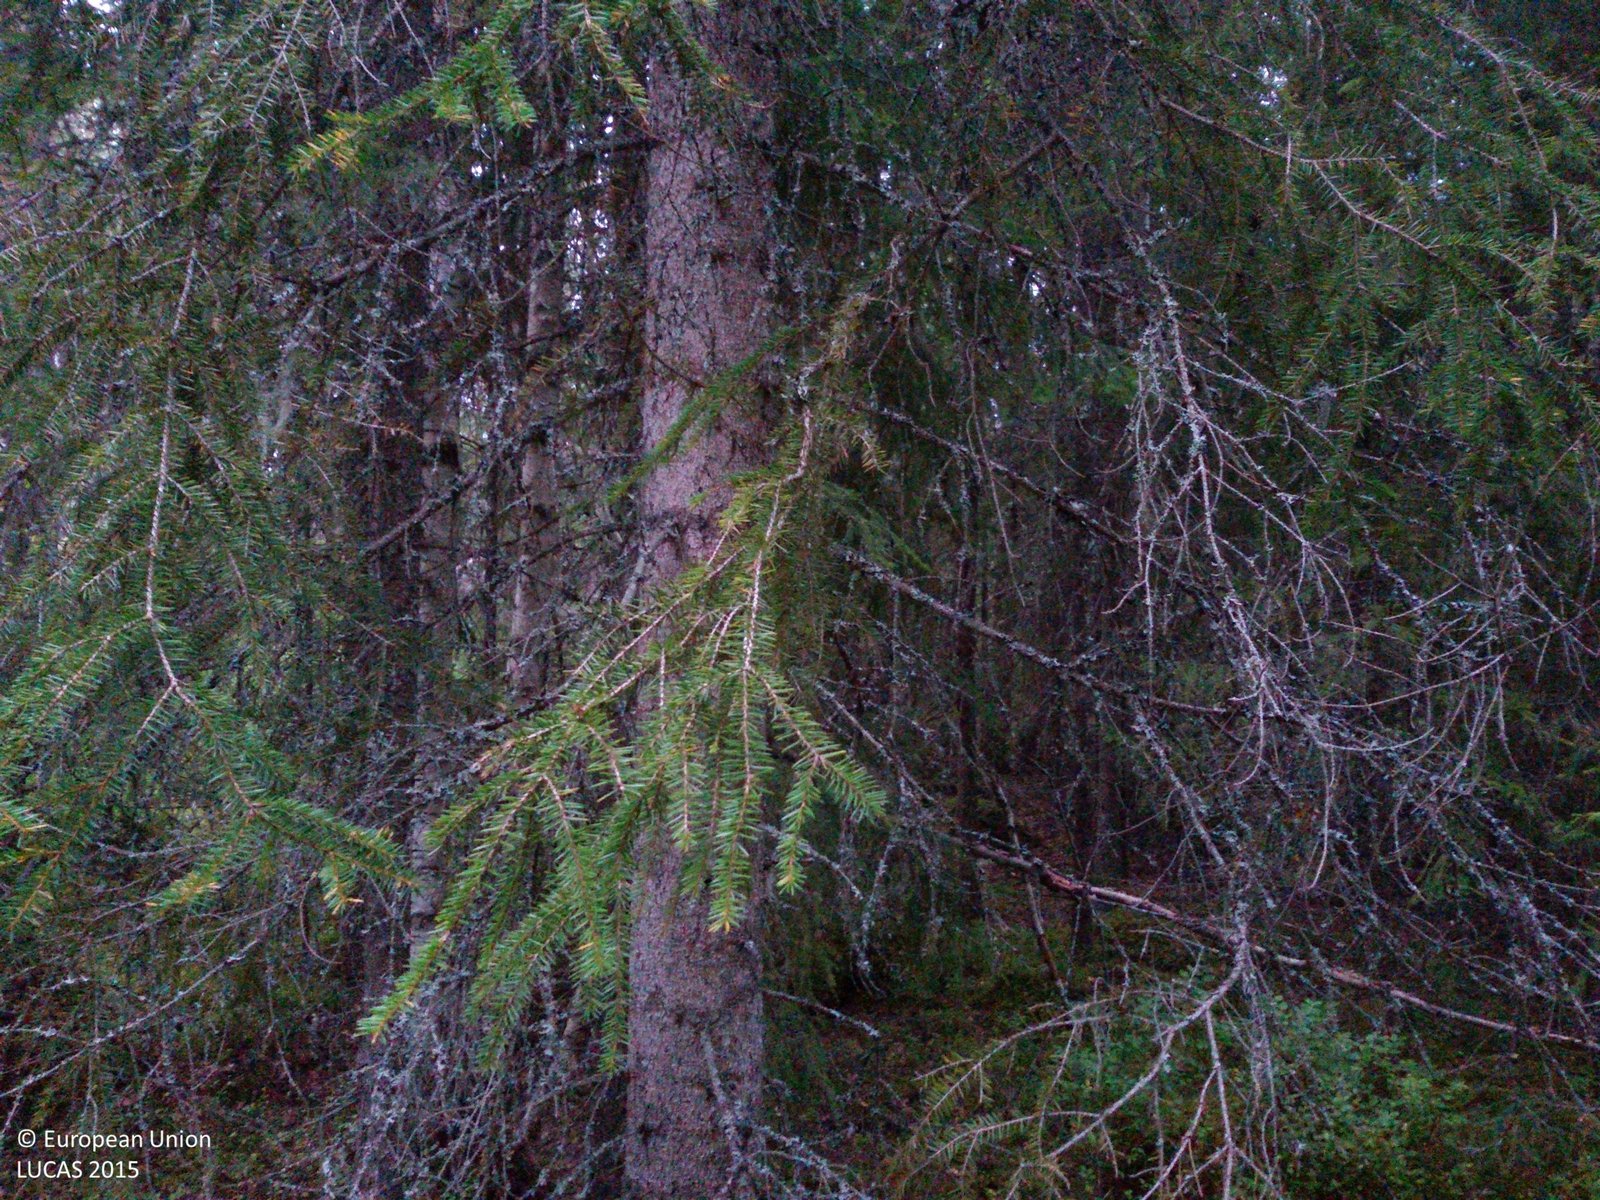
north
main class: Woodland
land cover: Spruce dominated mixed woodland
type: boreal forest
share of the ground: 50 - 75 %
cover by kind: coniferous forest trees 40 %, broadleaved forest trees 30 %, herbaceous plants 30 %
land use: Forestry
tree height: > 5 m
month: September
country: SE
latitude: 60.9866
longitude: 15.6972
